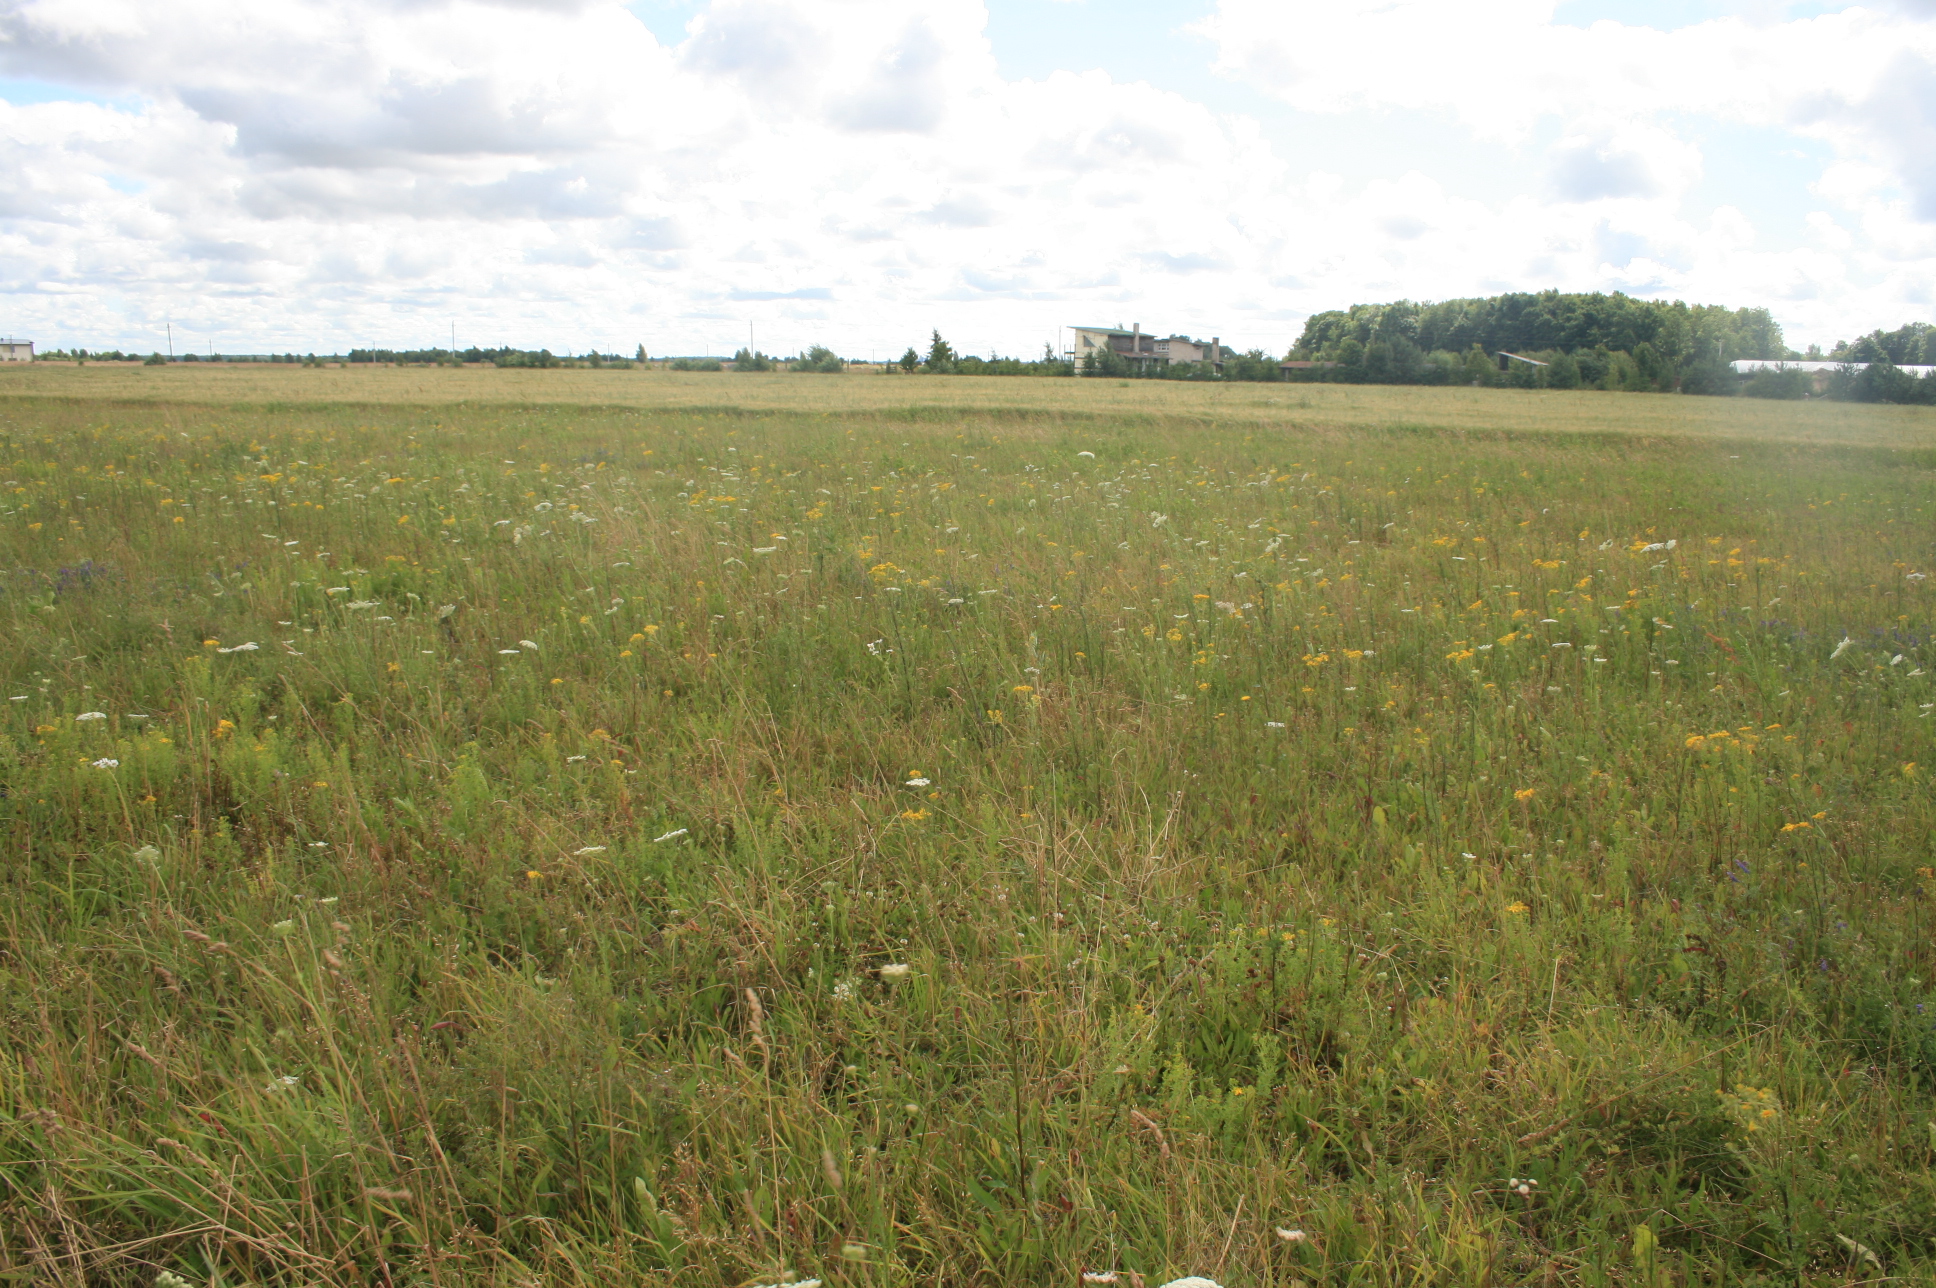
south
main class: Grassland
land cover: Grassland without tree/shrub cover
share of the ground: > 75 %
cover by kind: herbaceous plants 100 %
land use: Agriculture (excluding fallow land and kitchen gardens)
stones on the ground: < 10 %
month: July
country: LT
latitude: 55.7467
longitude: 21.2407
